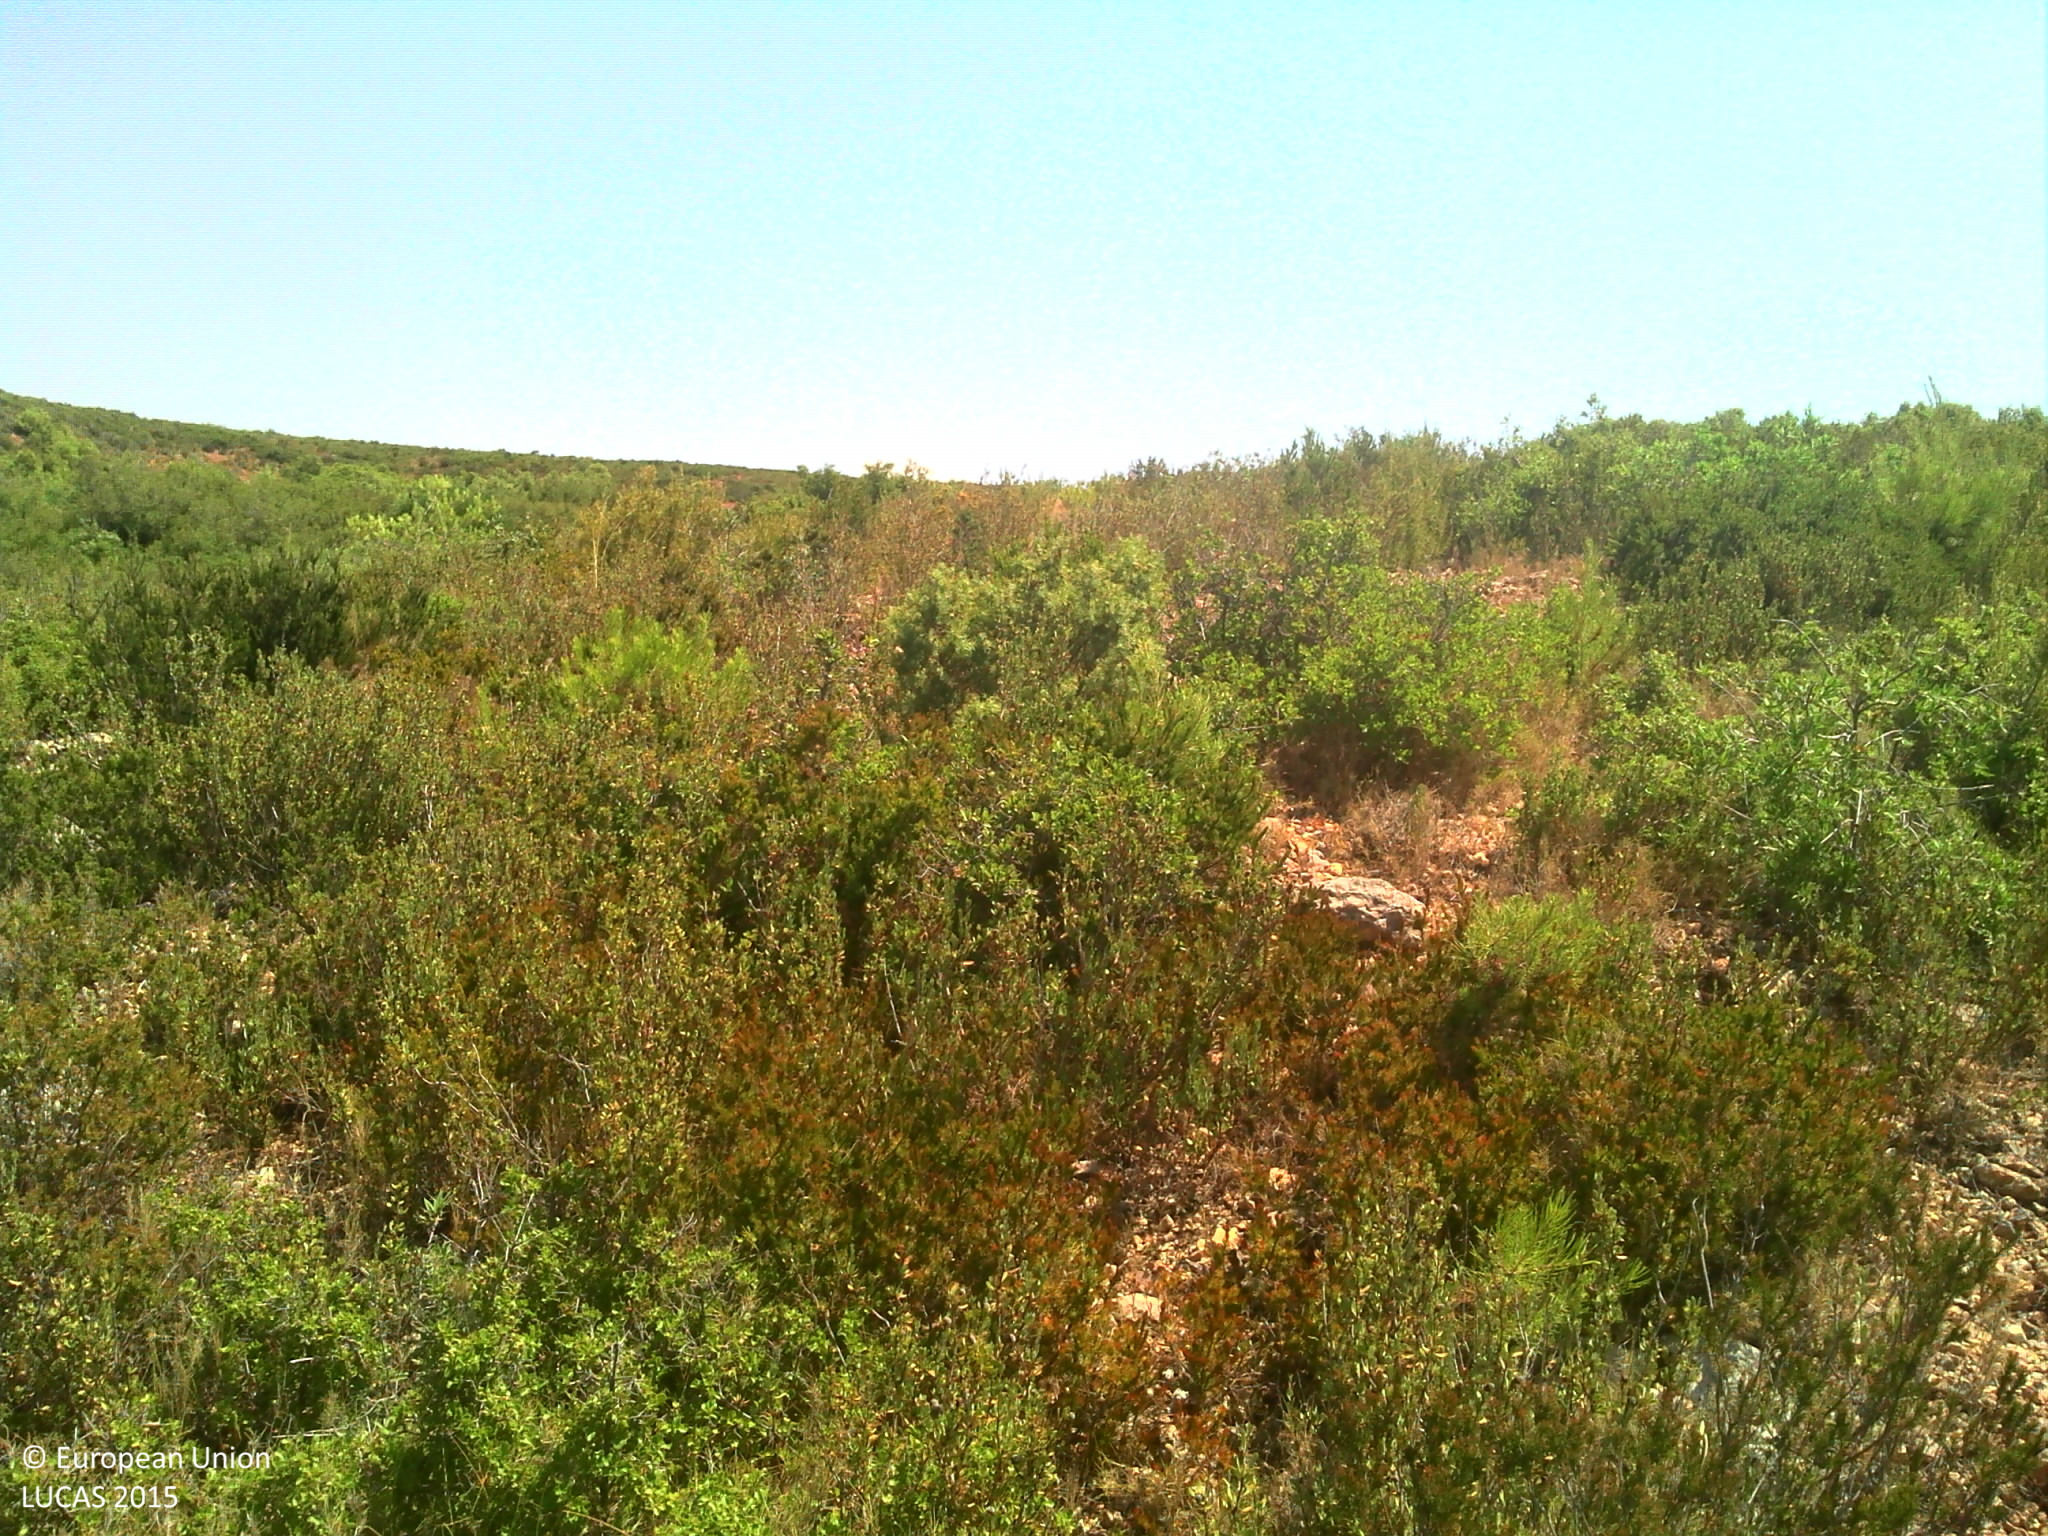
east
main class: Shrubland
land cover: Shrubland without tree cover
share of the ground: > 75 %
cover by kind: shrubs 80 %, unconsolidated bare surface 15 %, consolidated bare surface 5 %
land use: Semi-natural and natural areas not in use
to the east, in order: Shrubland without tree cover; Tracks; Shrubland without tree cover; Tracks; Shrubland without tree cover; Tracks; Shrubland without tree cover; Tracks; Shrubland without tree cover; Tracks; Pine dominated coniferous woodland; Shrubland without tree cover; Tracks; Pine dominated coniferous woodland; Tracks; Shrubland without tree cover
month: August
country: FR
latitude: 43.4660
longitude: 5.2759
